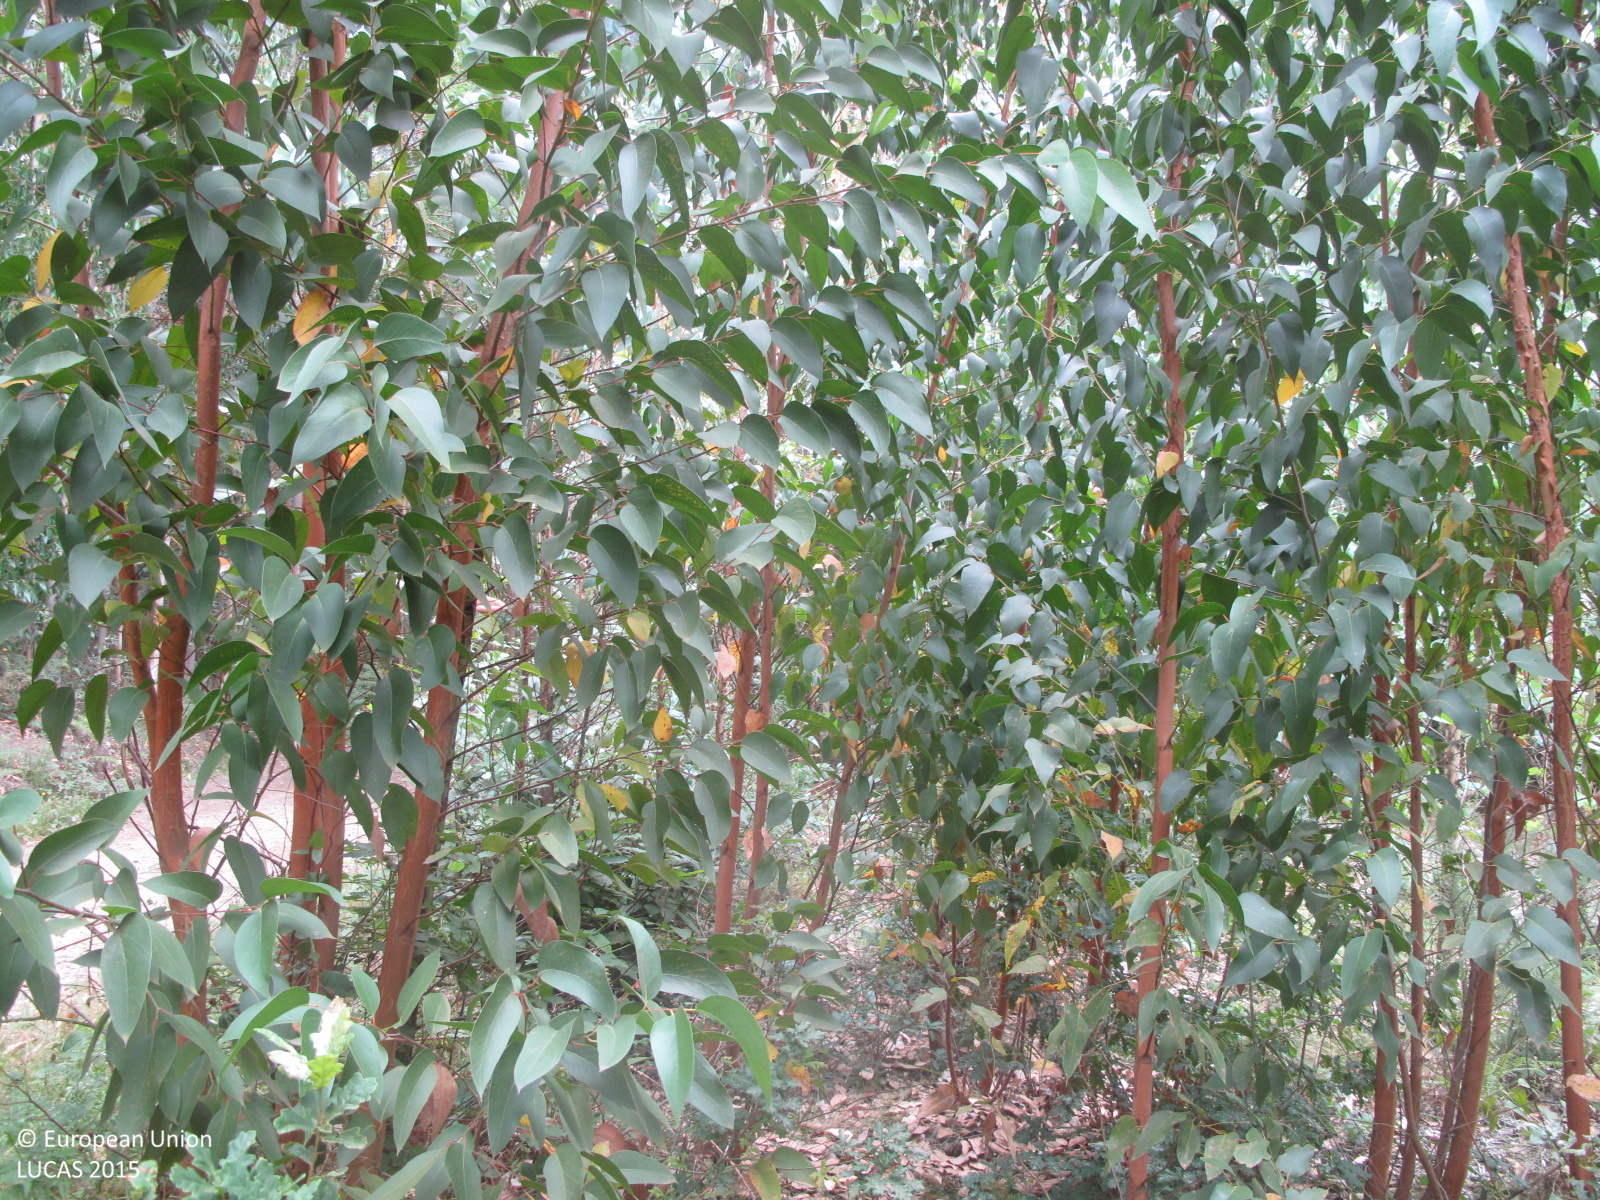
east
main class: Woodland
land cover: Broadleaved woodland
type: exotic forest
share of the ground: 50 - 75 %
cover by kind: broadleaved forest trees 60 %, herbaceous plants 20 %, shrubs 10 %, unconsolidated bare surface 10 %
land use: Forestry
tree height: > 5 m
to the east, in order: Broadleaved woodland; Tracks; Broadleaved woodland; Tracks; Broadleaved woodland
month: July
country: ES
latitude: 43.2645
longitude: -8.0697
